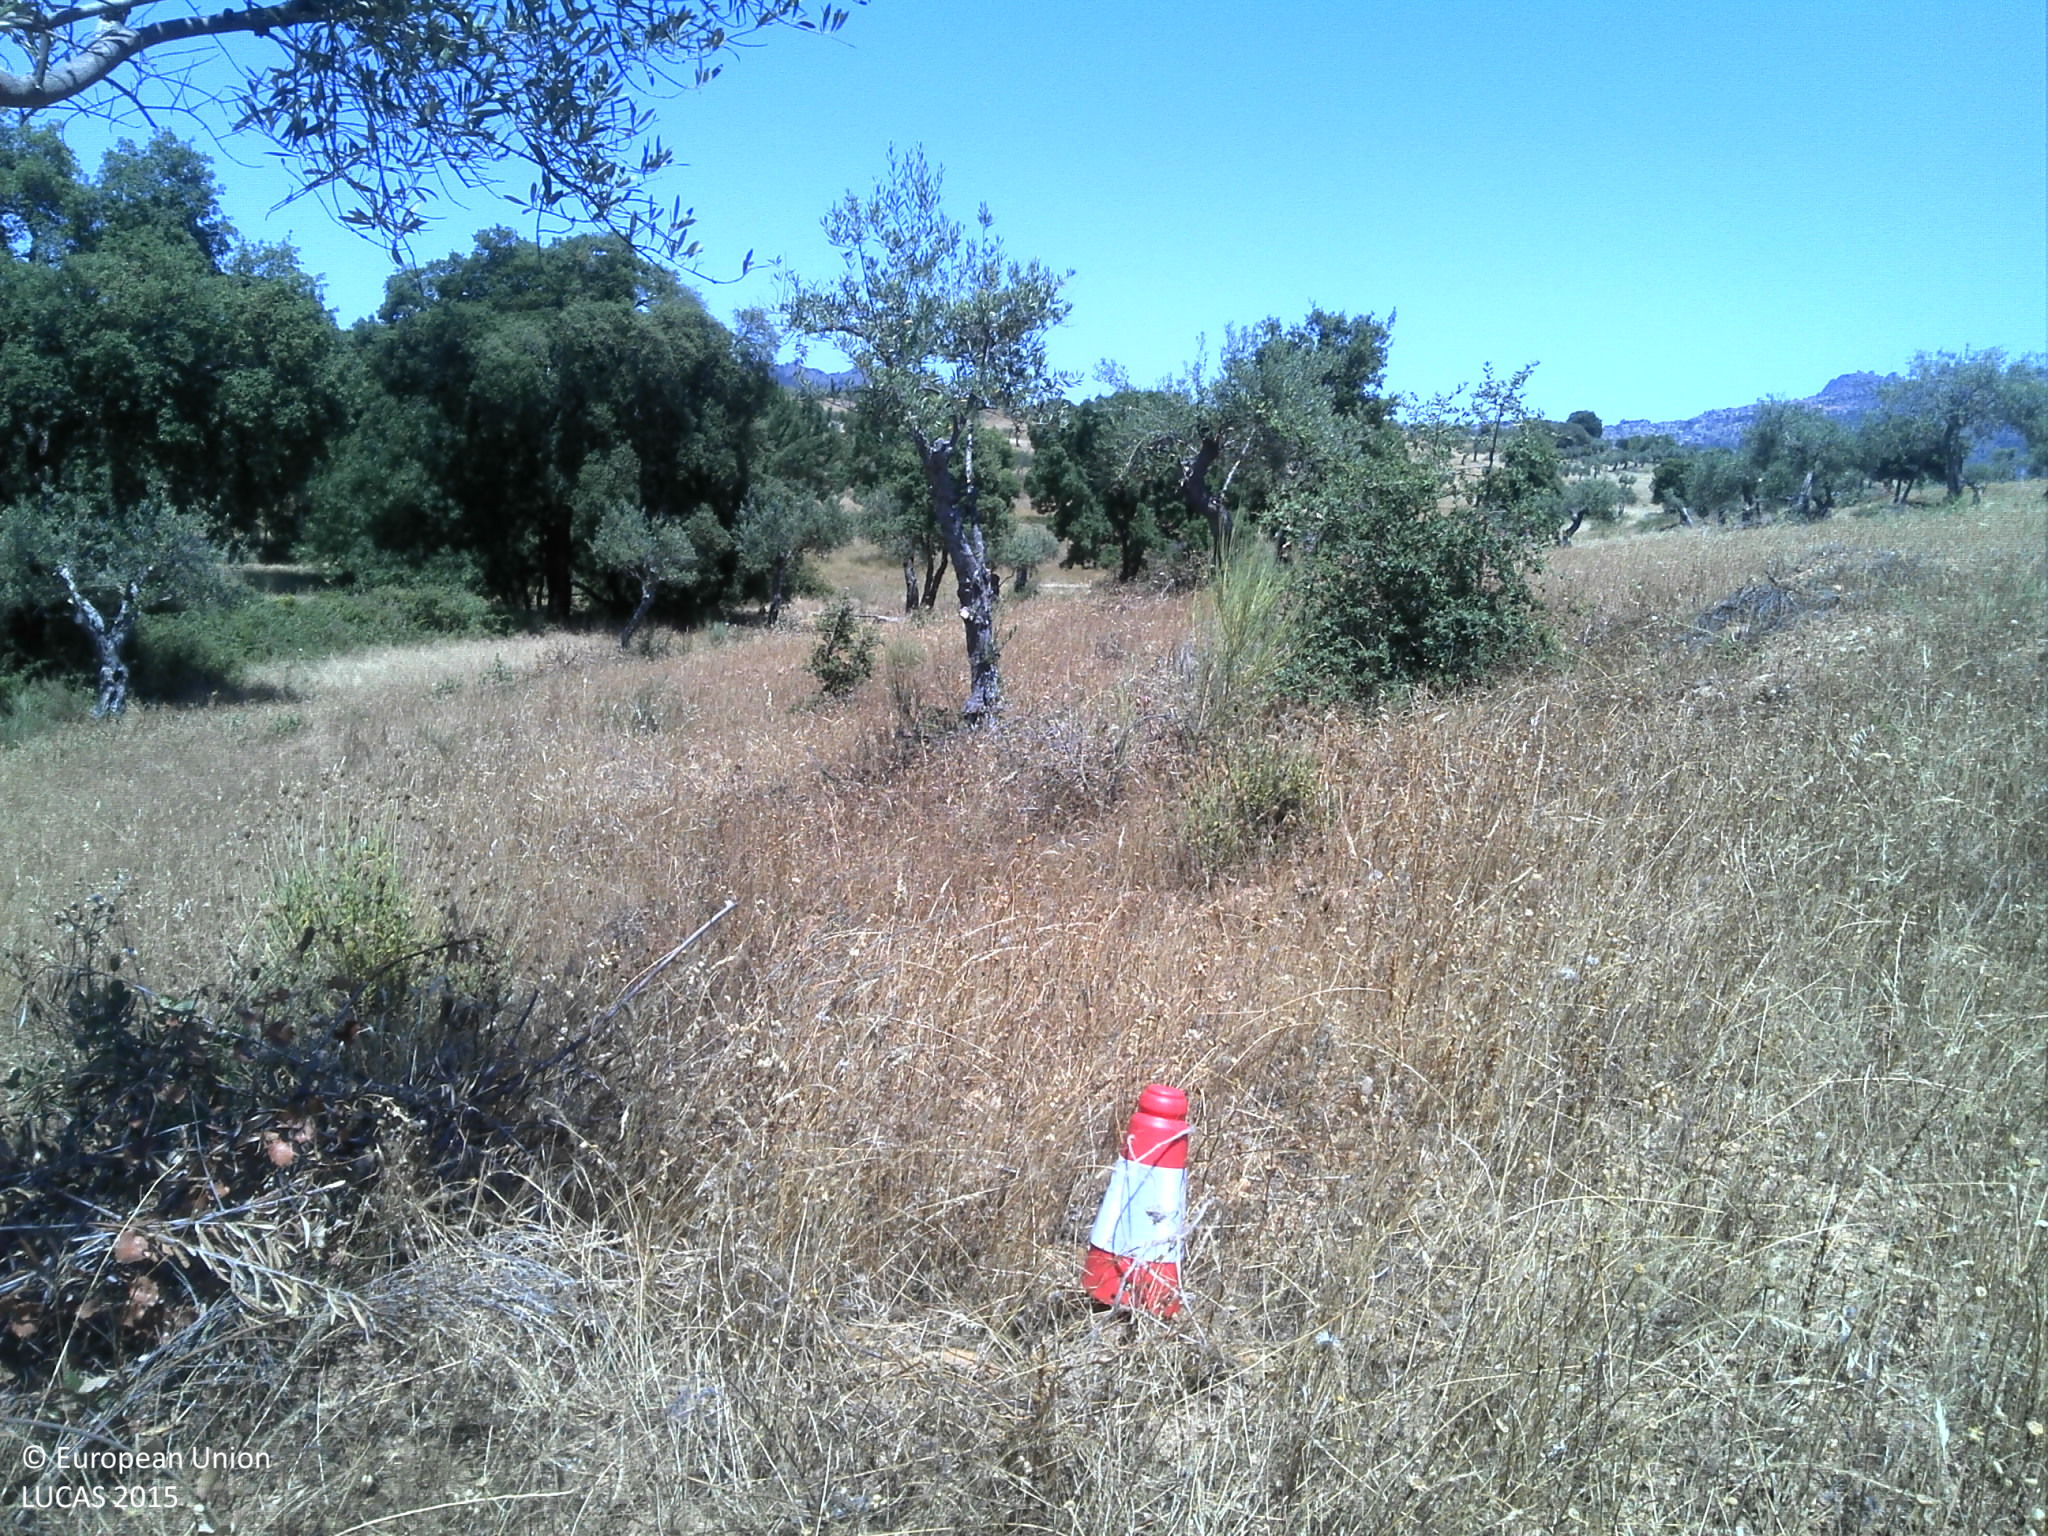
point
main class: Cropland
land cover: Olive groves
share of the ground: 25 - 50 %
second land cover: Grassland without tree/shrub cover
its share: 50 - 75 %
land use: Agriculture (excluding fallow land and kitchen gardens)
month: June
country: PT
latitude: 40.0322
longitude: -7.1692
